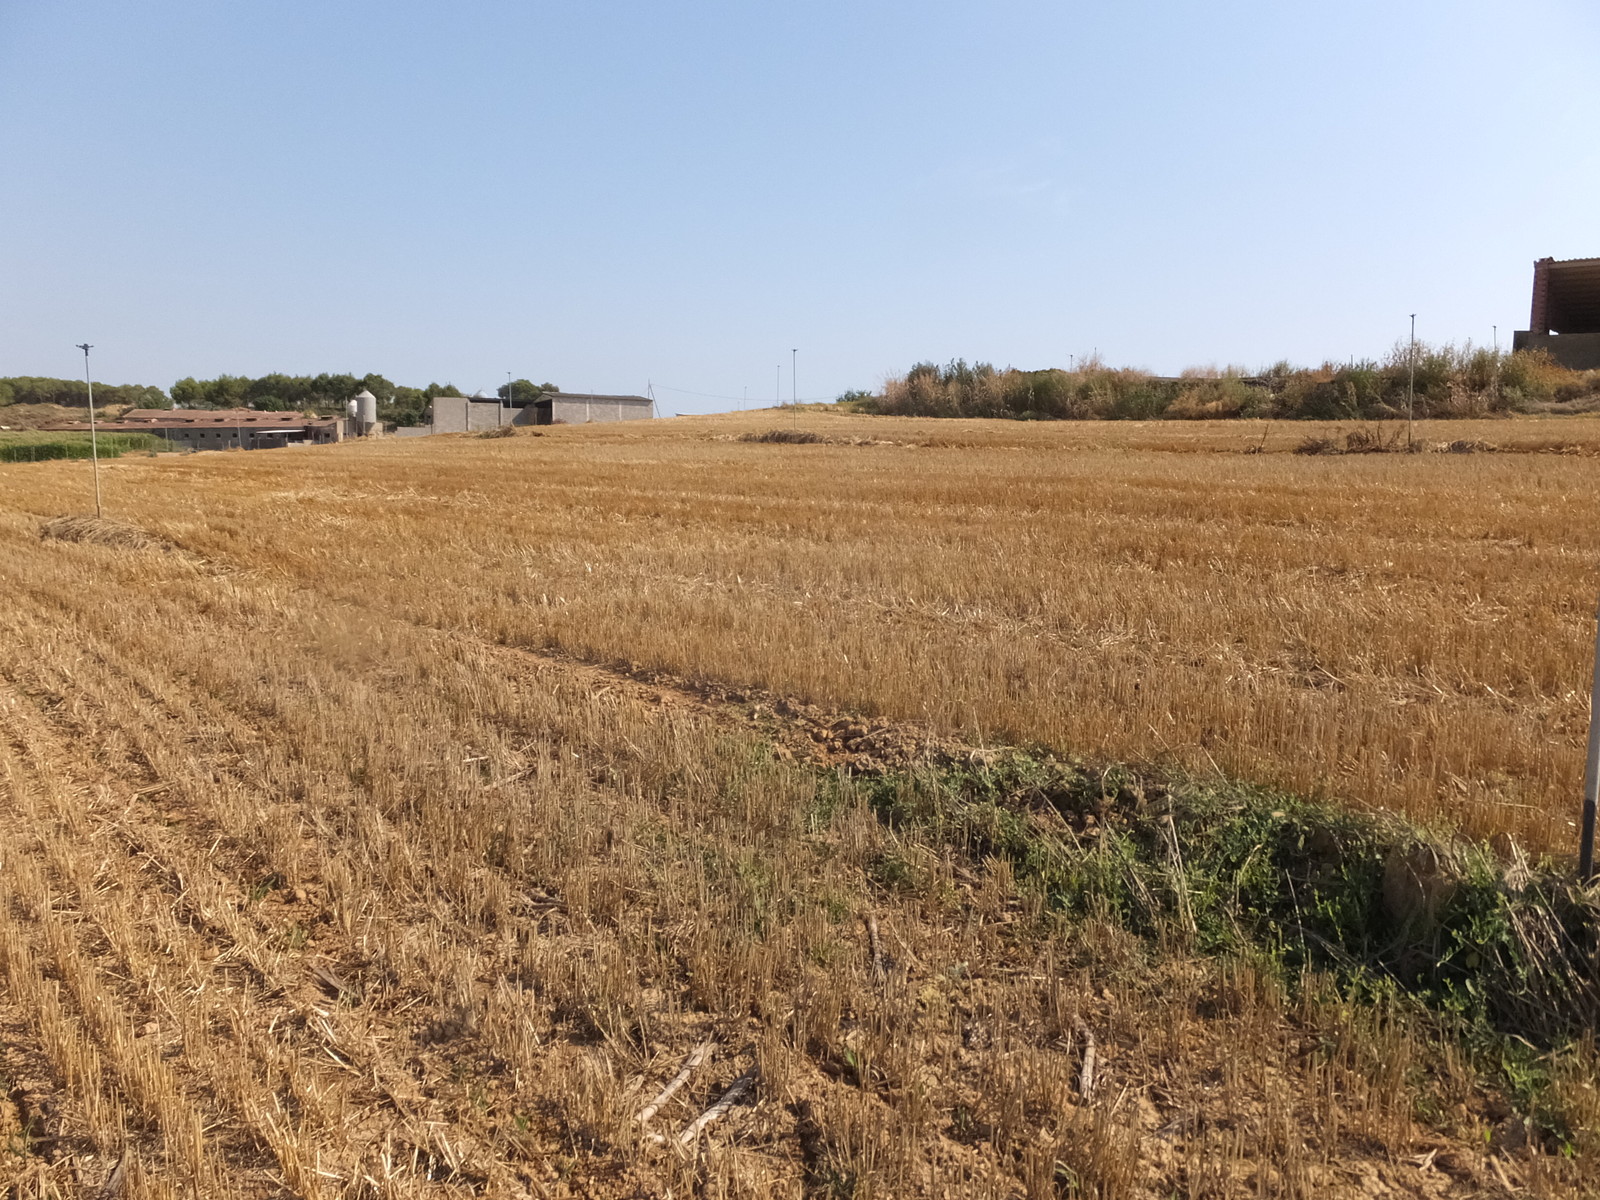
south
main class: Cropland
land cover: Maize
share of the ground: < 10 %
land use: Agriculture (excluding fallow land and kitchen gardens)
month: July
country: ES
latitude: 41.7001
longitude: 0.3363
